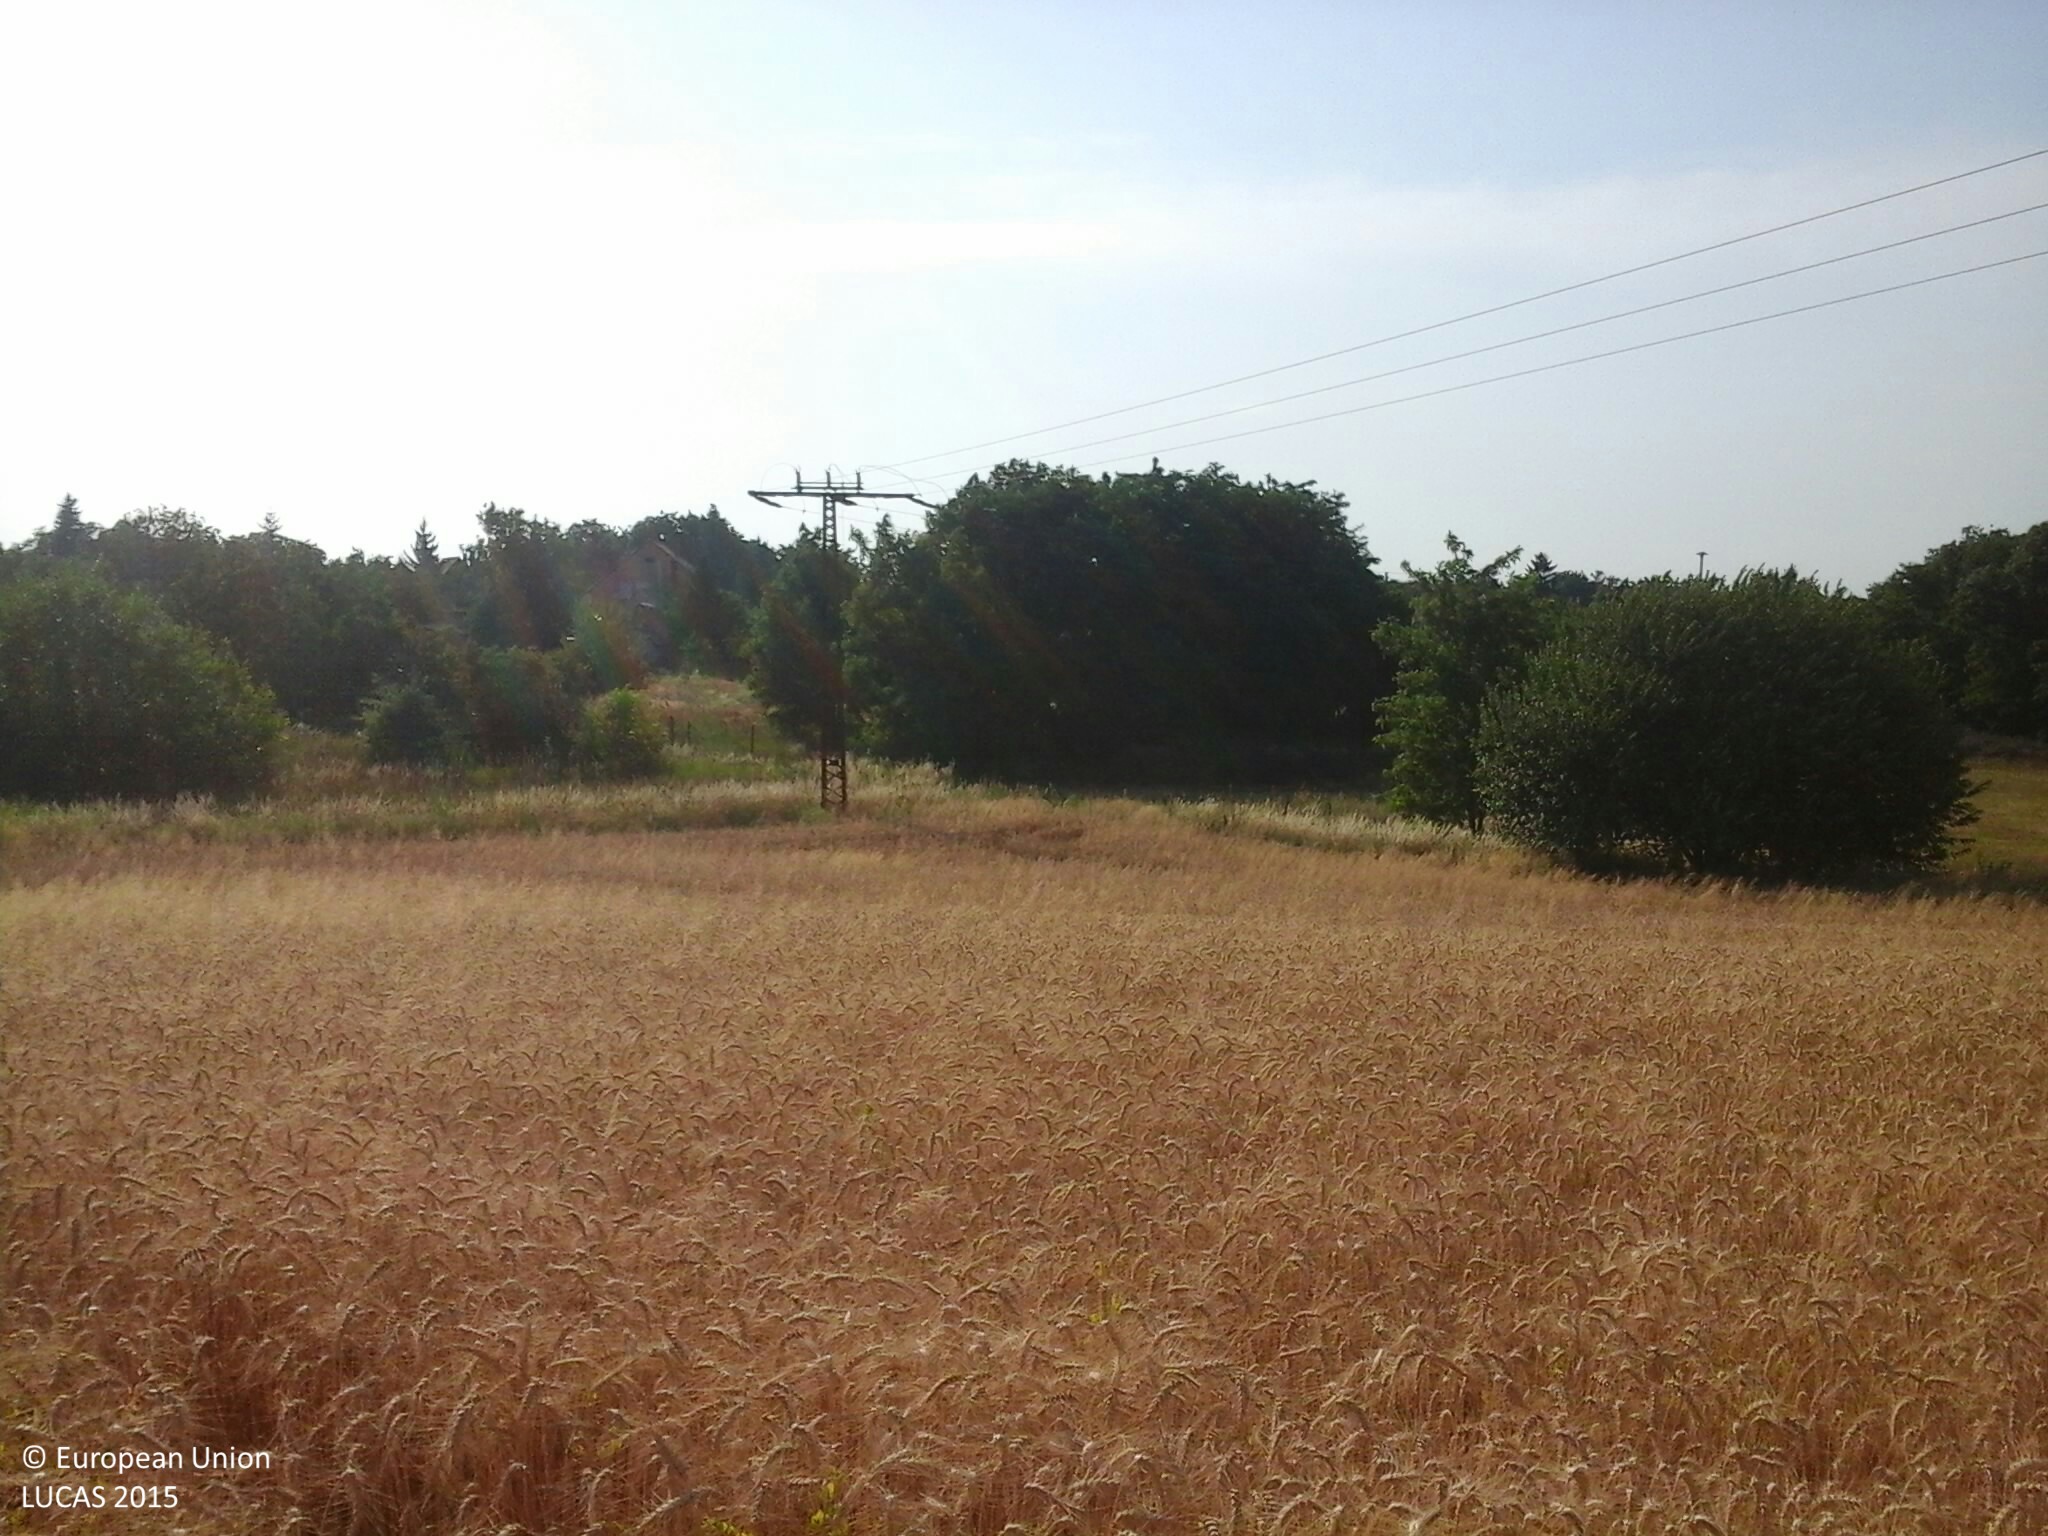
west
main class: Cropland
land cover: Common wheat
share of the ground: > 75 %
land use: Agriculture (excluding fallow land and kitchen gardens)
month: July
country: HU
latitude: 47.1628
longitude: 17.3803
